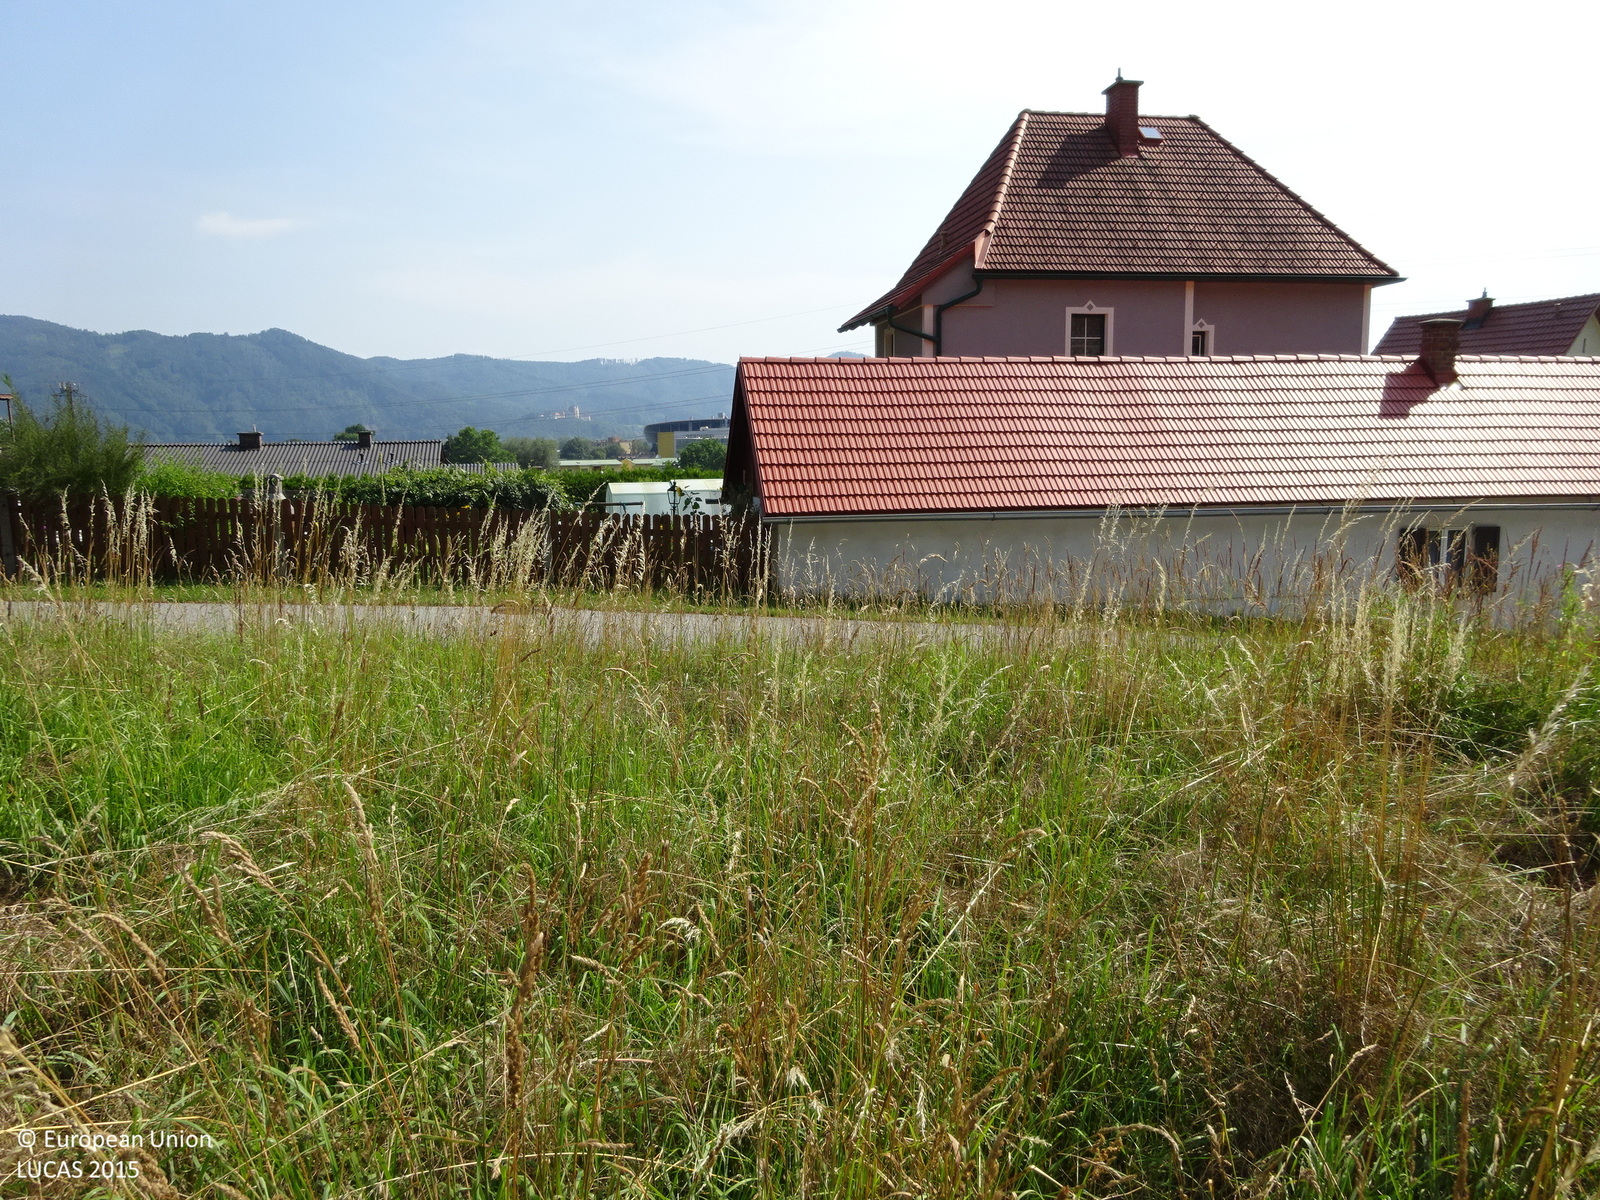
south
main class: Grassland
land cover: Grassland without tree/shrub cover
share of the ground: > 75 %
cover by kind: herbaceous plants 100 %
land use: Agriculture (excluding fallow land and kitchen gardens)
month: July
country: AT
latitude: 47.1382
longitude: 15.3398
